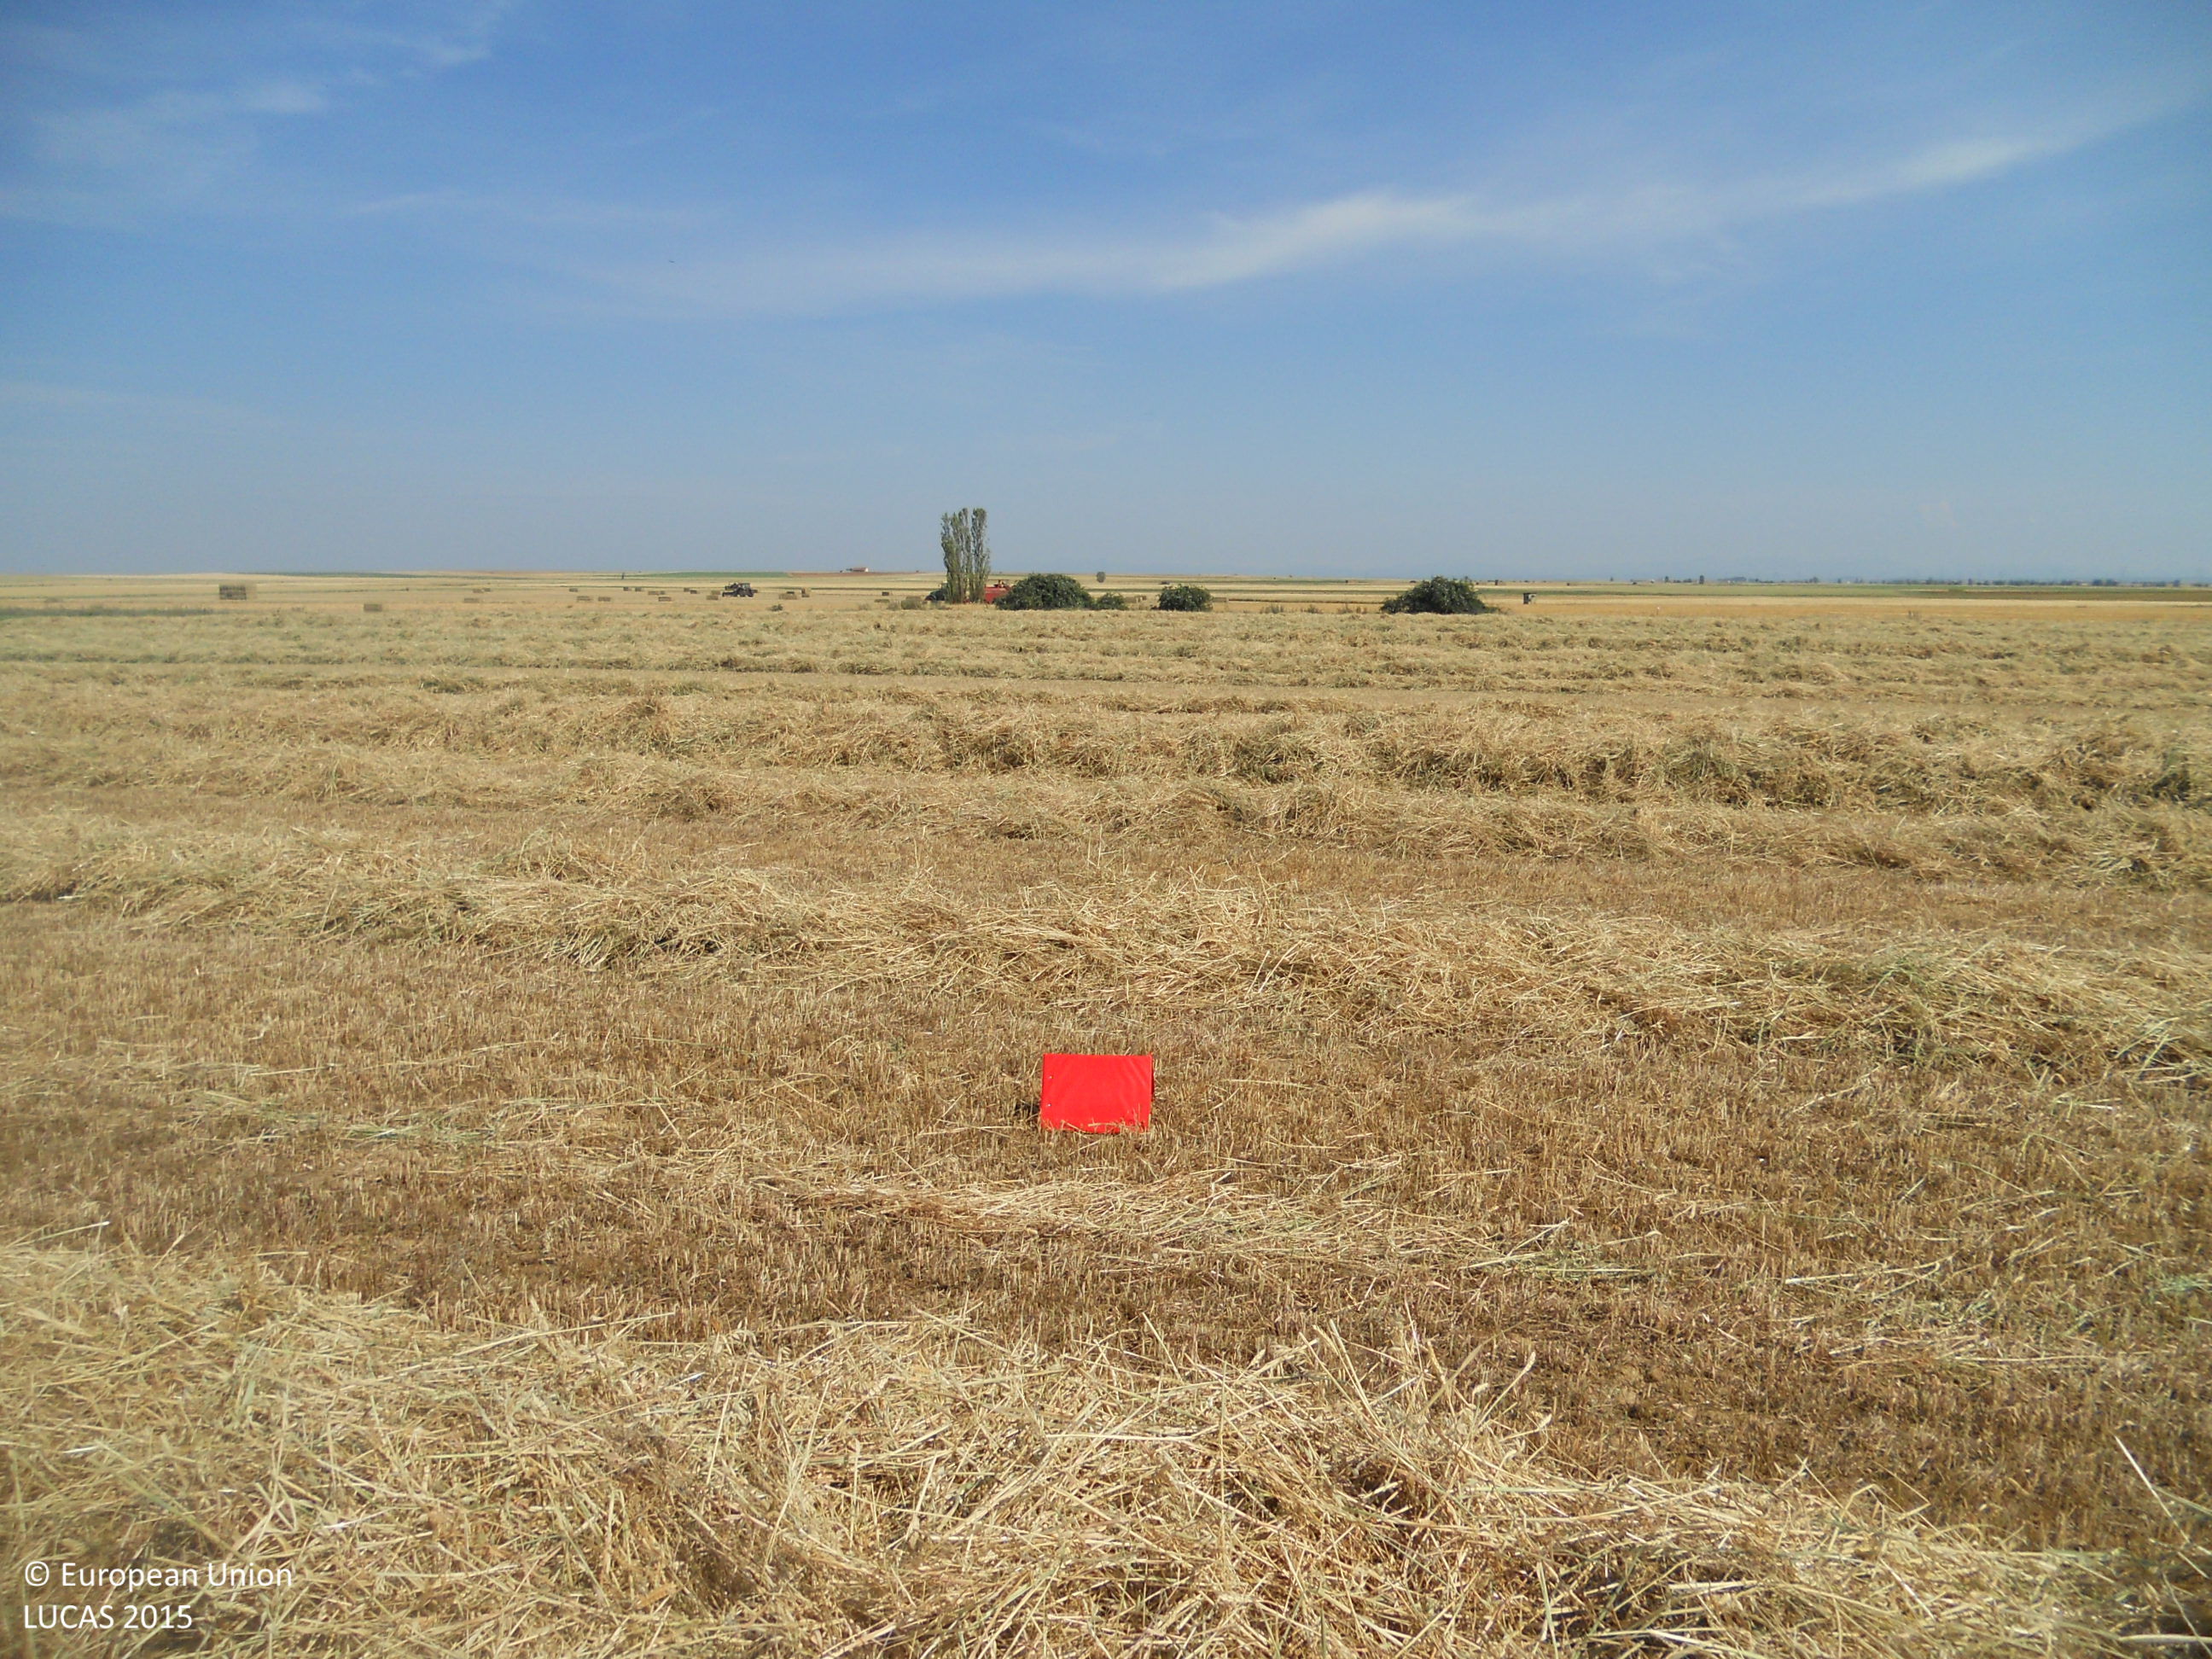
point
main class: Cropland
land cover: Mixed cereals for fodder
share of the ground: < 10 %
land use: Agriculture (excluding fallow land and kitchen gardens)
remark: Harvested field
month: June
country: ES
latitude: 42.3565
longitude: -5.3506
